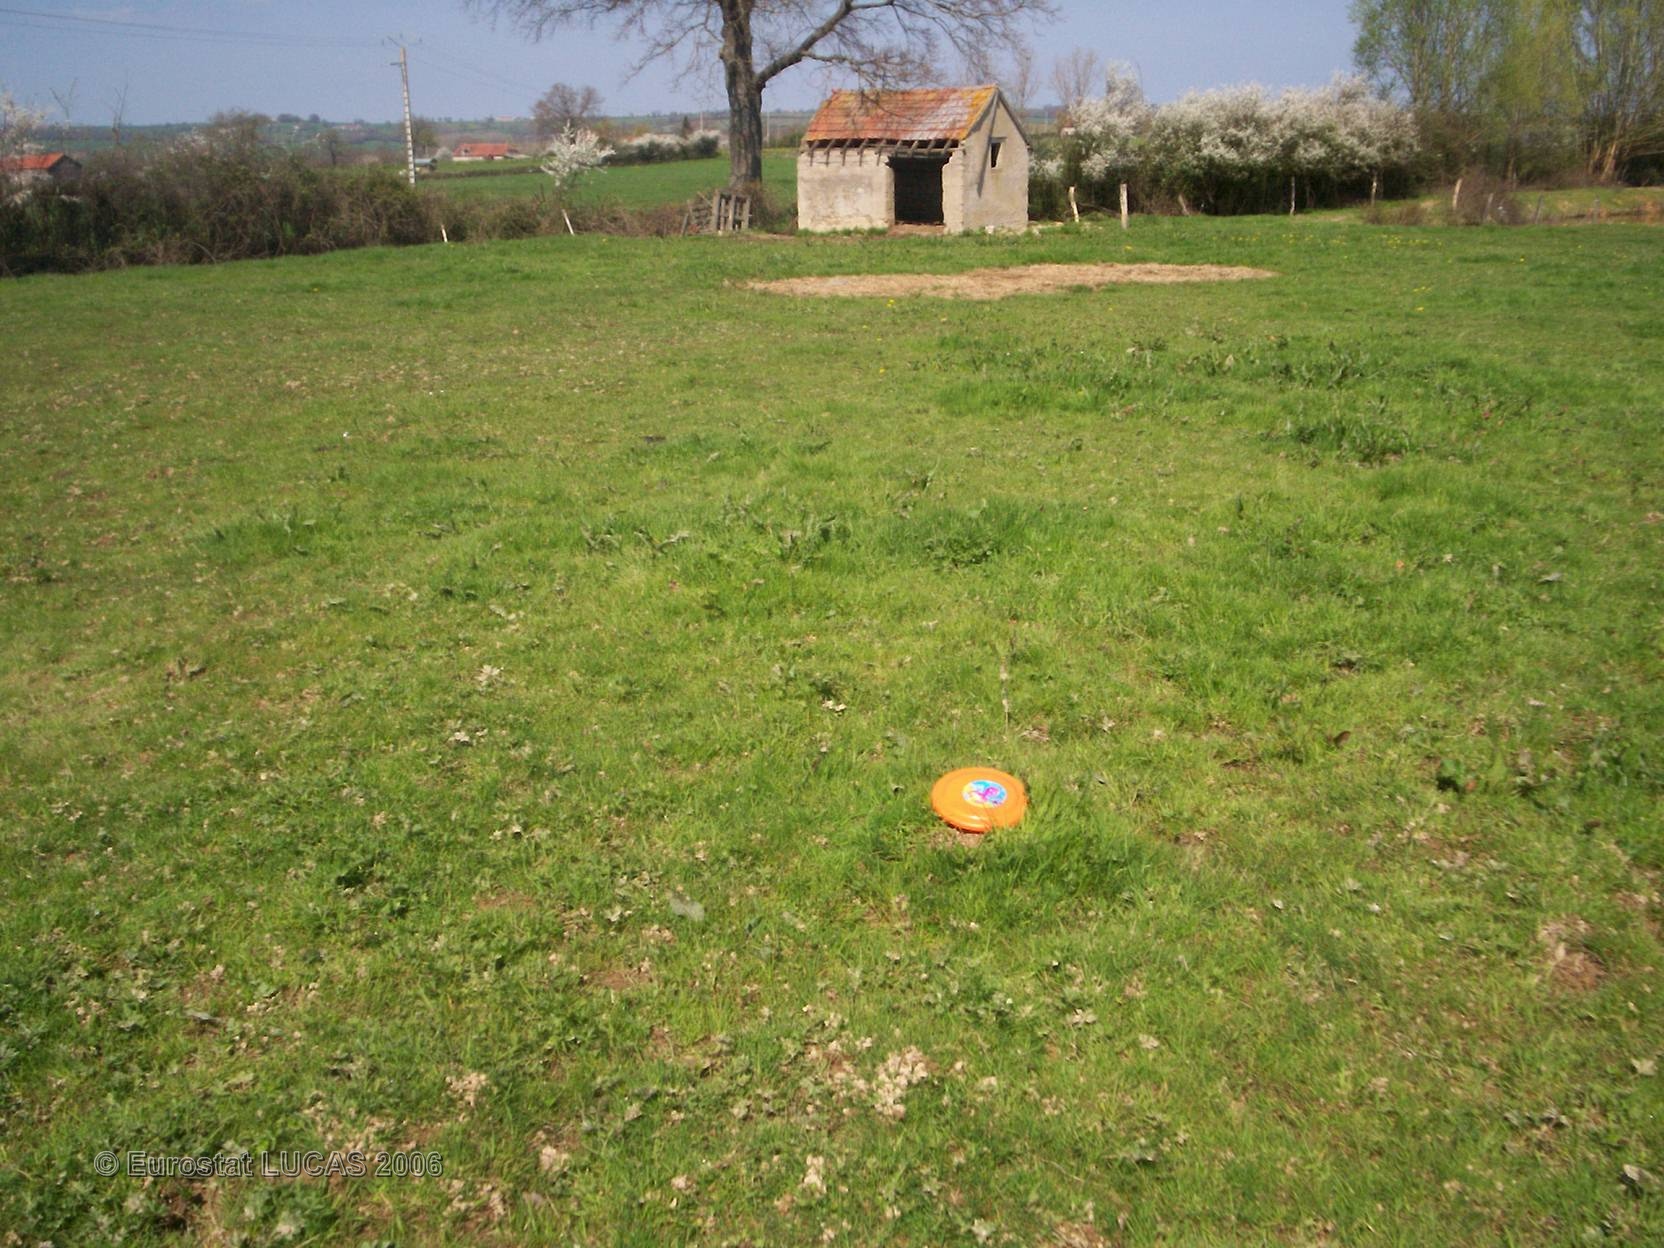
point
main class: Grassland
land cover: Grassland without tree/shrub cover
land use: Agriculture (excluding fallow land and kitchen gardens)
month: April
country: FR
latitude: 46.5960
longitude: 3.0658
